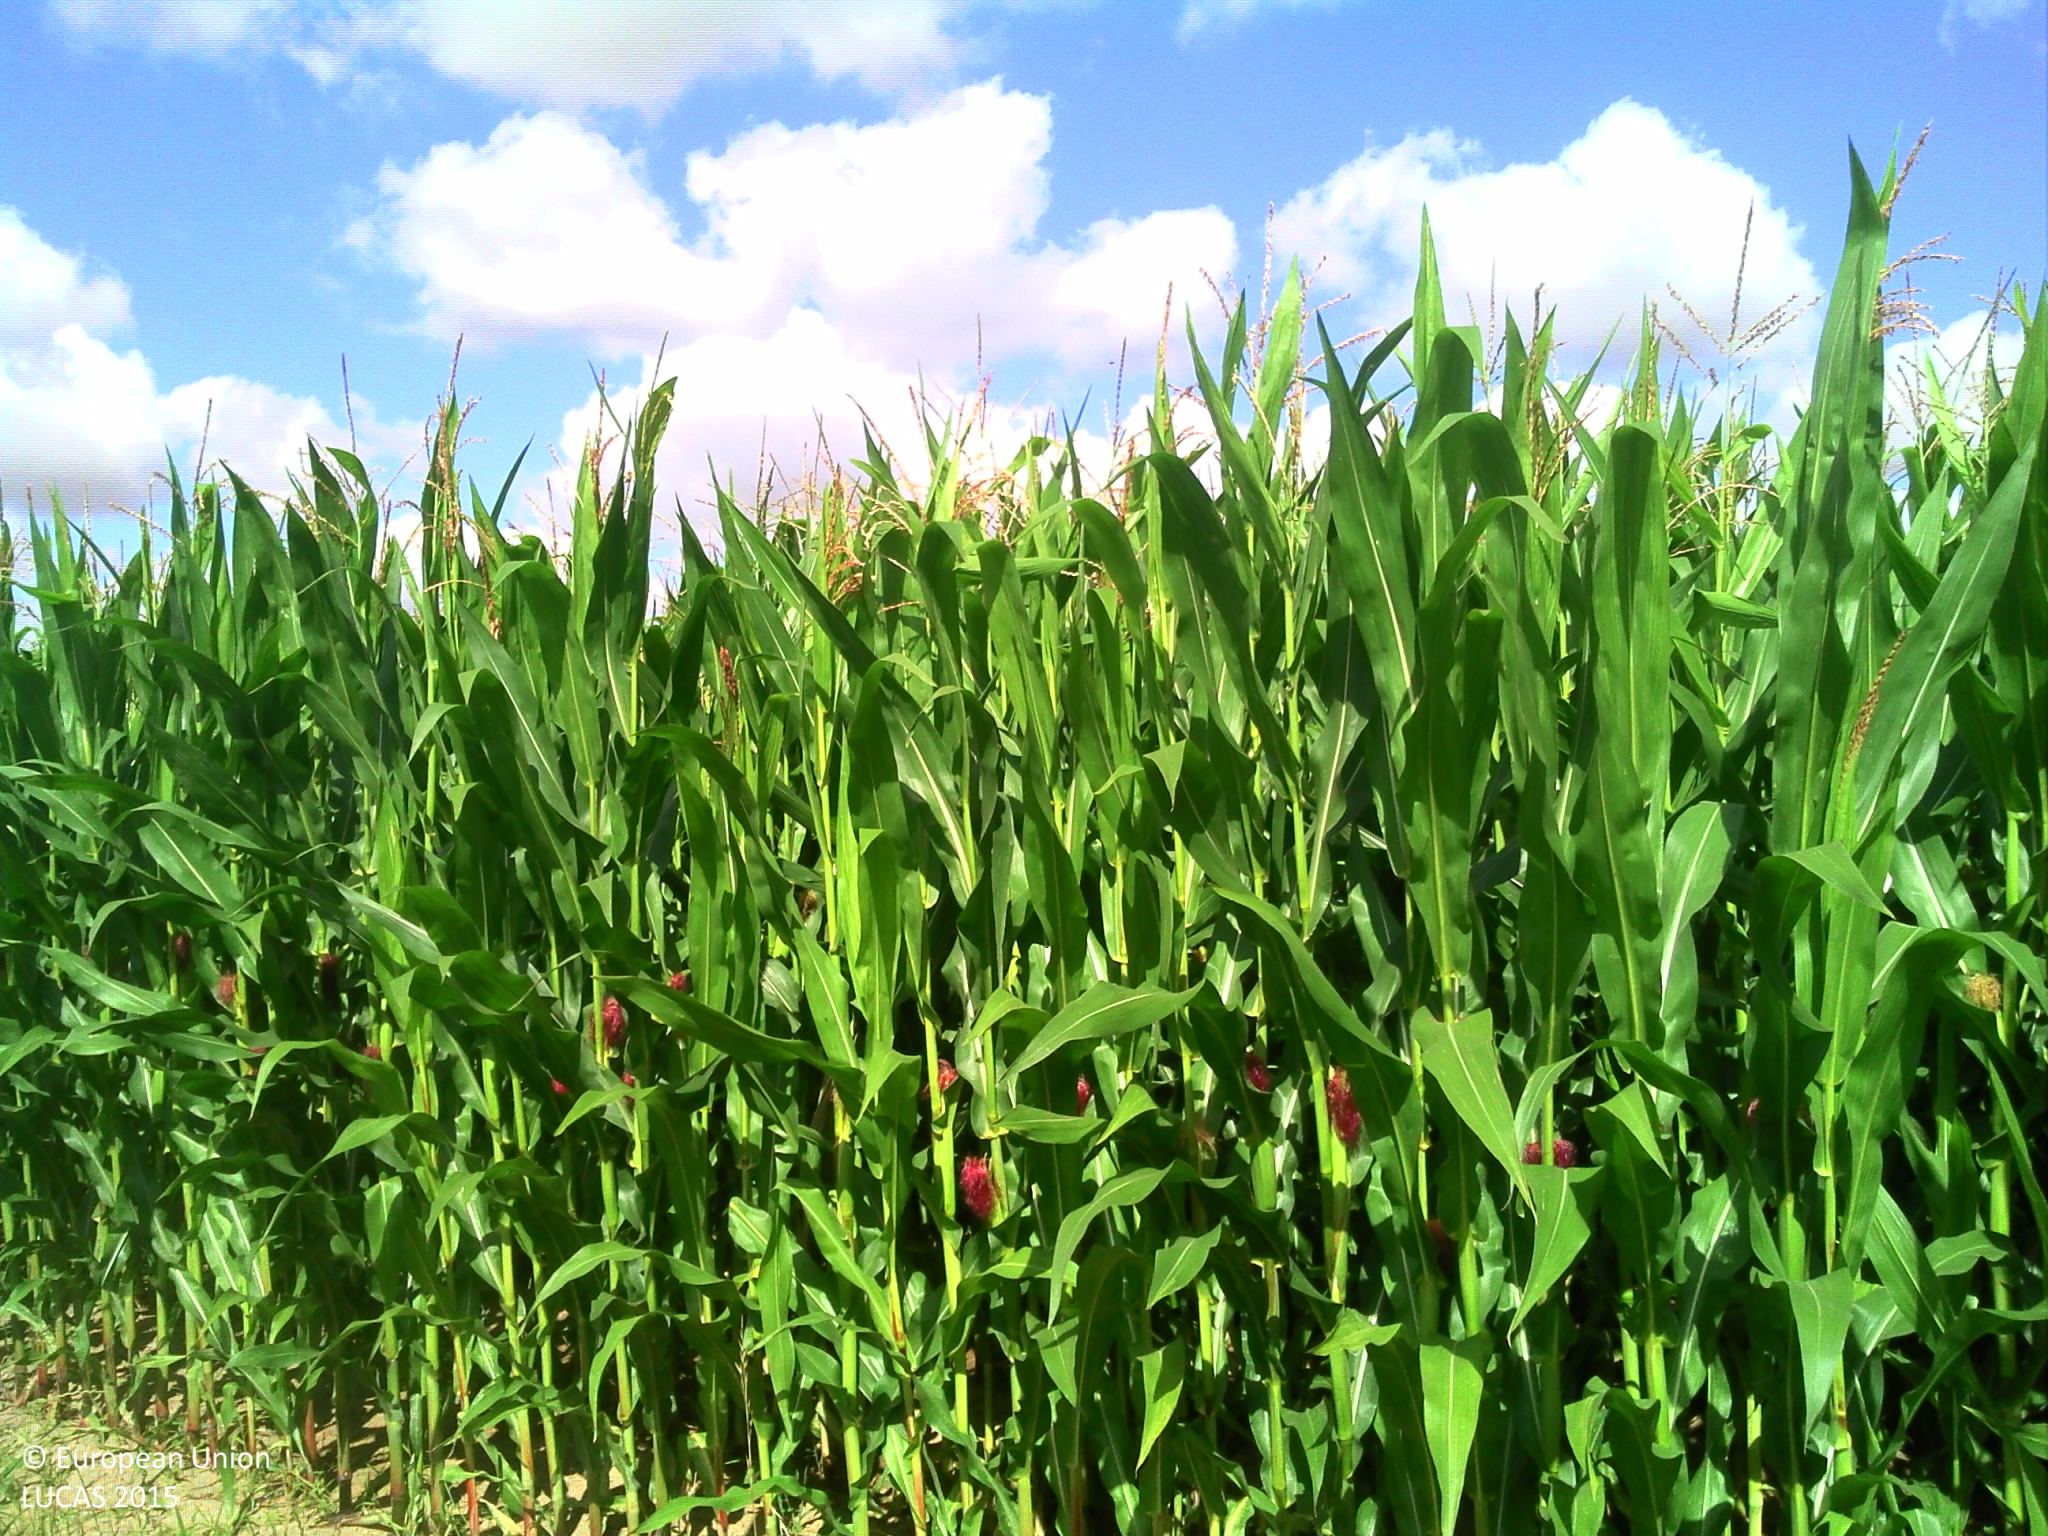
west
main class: Cropland
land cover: Maize
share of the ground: > 75 %
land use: Agriculture (excluding fallow land and kitchen gardens)
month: July
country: FR
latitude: 47.0706
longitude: 0.5122
